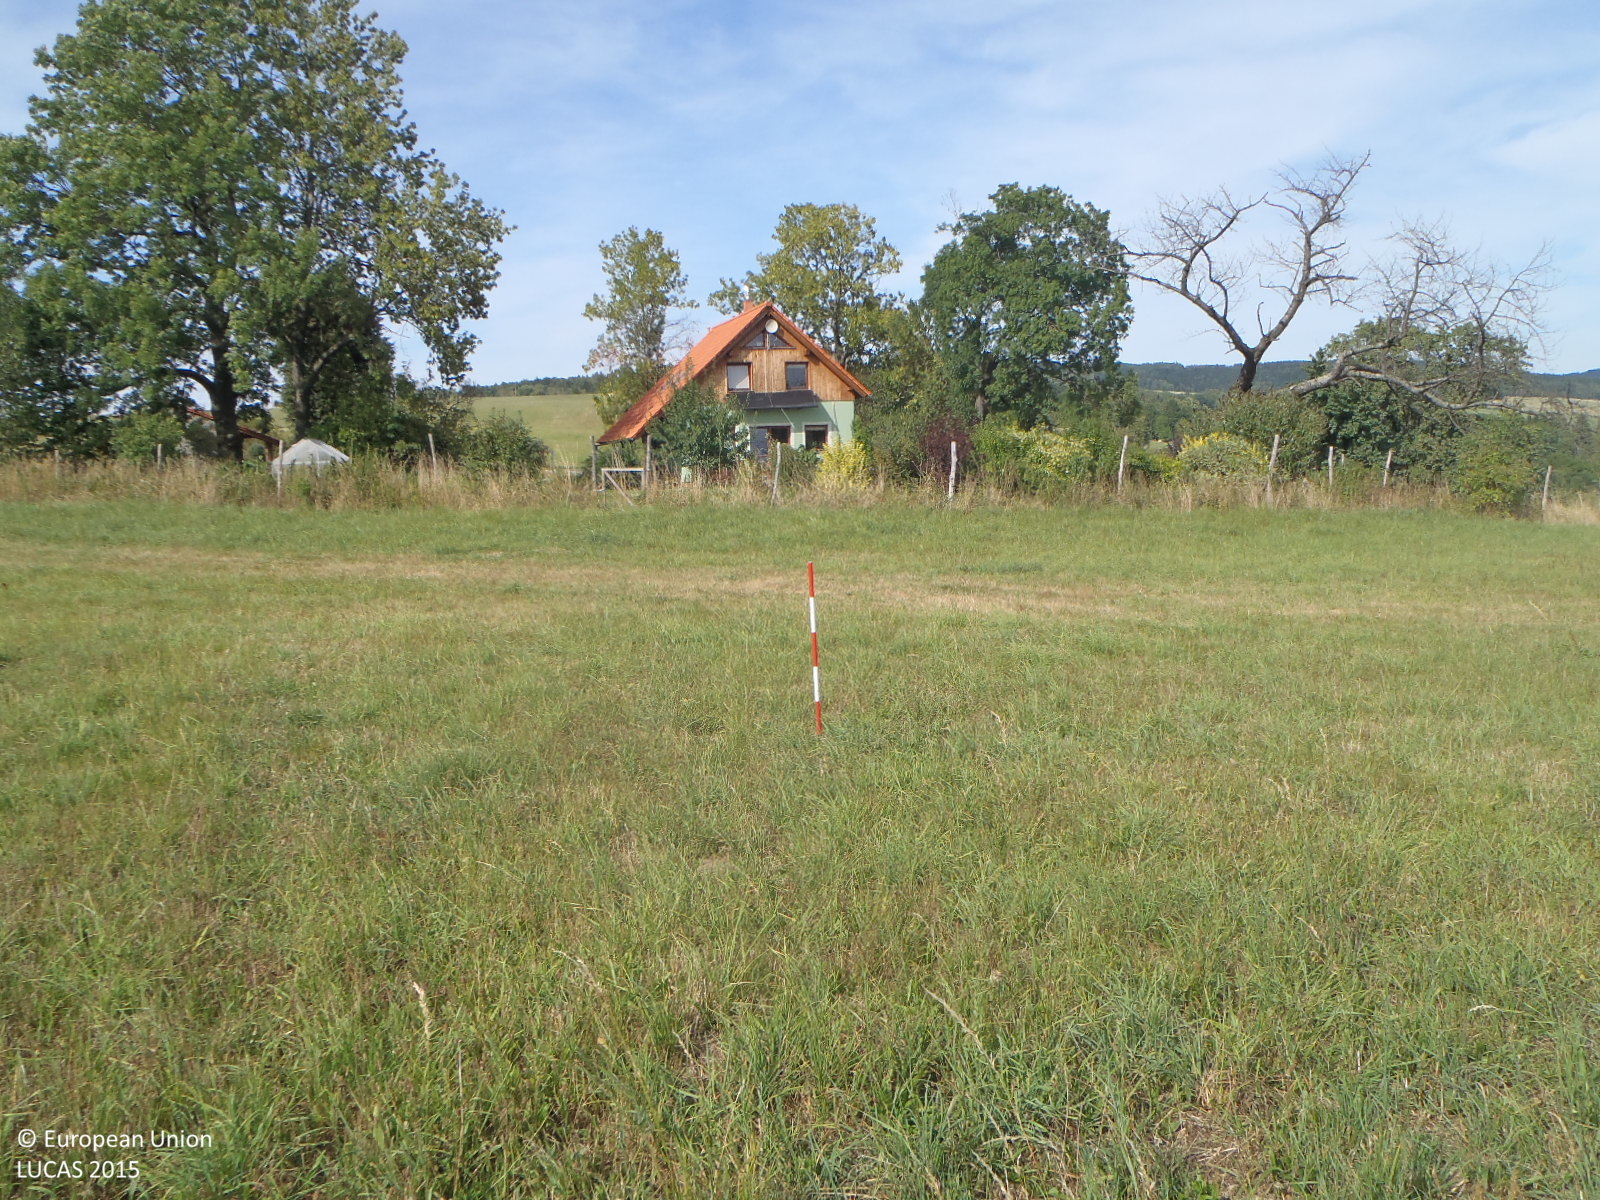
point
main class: Grassland
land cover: Grassland without tree/shrub cover
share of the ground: > 75 %
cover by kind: herbaceous plants 100 %
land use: Agriculture (excluding fallow land and kitchen gardens)
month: August
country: CZ
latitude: 50.8318
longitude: 14.9865
